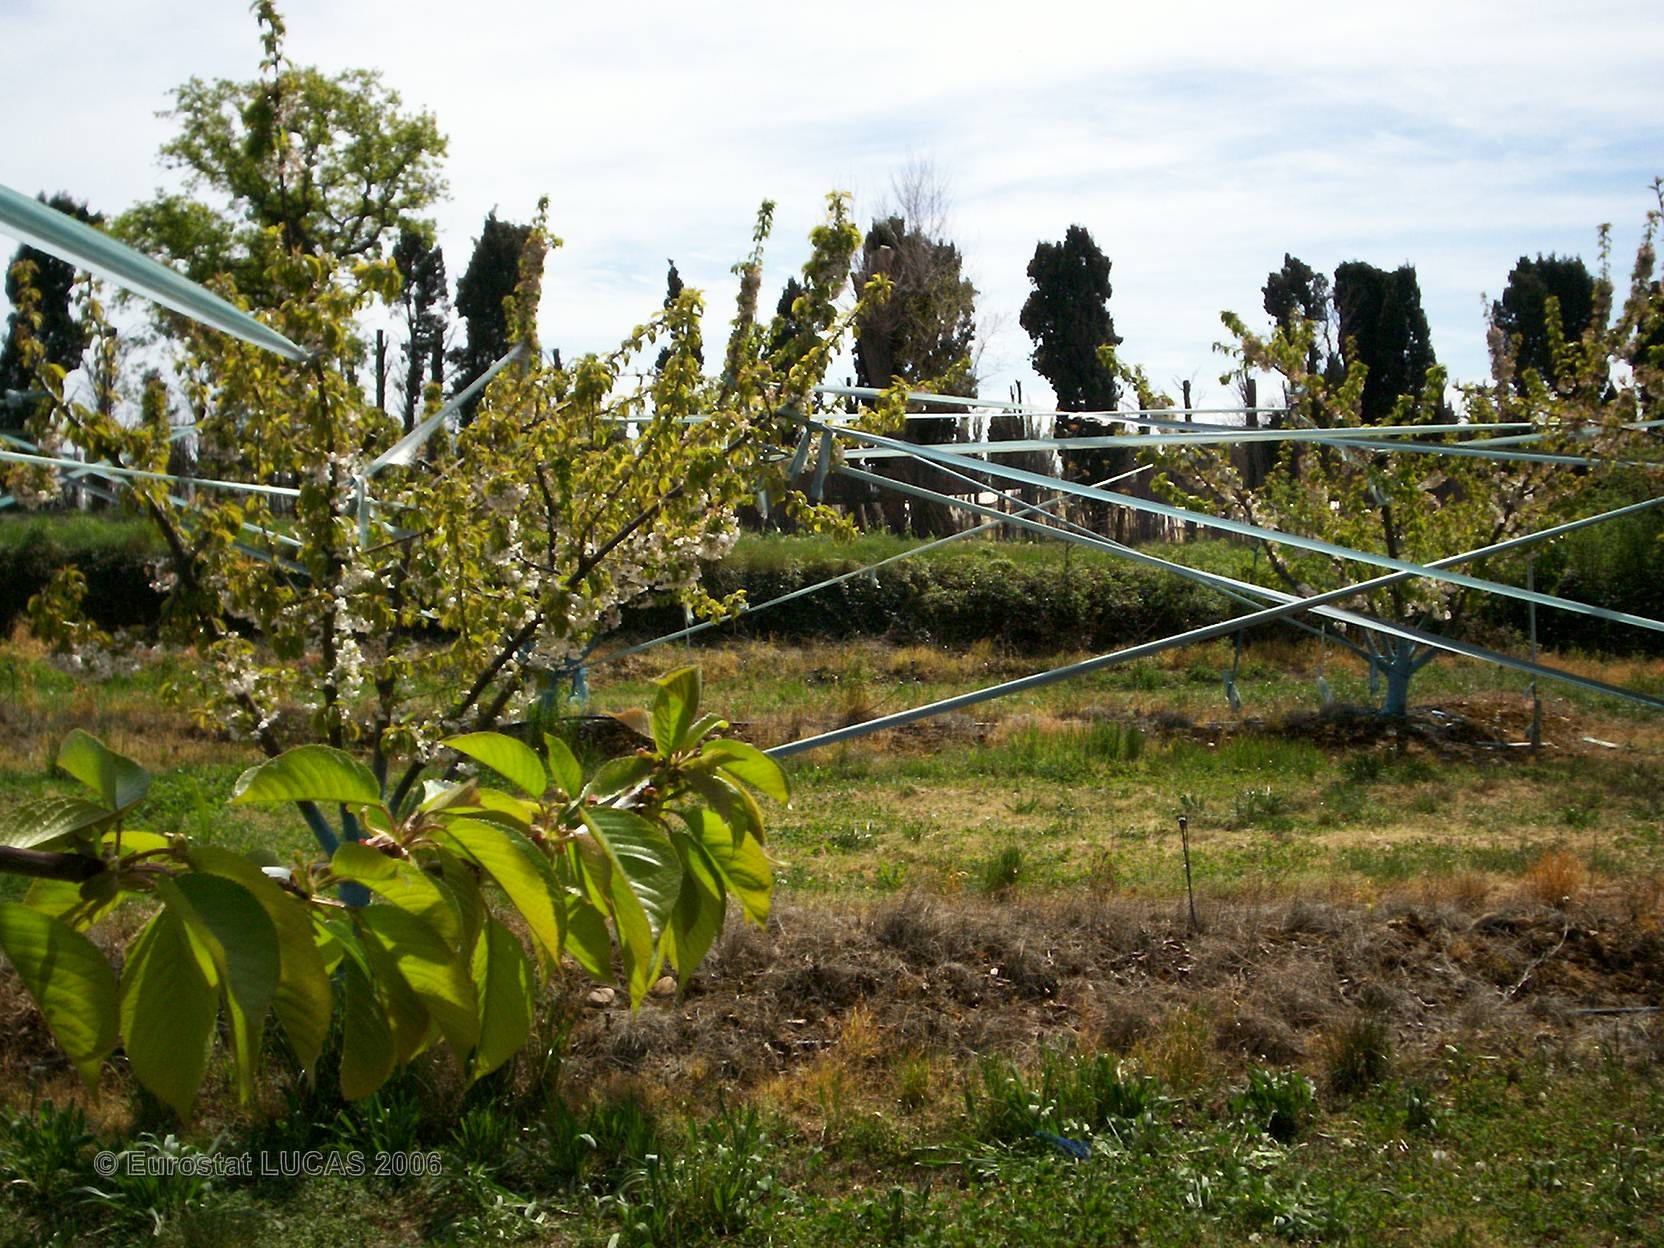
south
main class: Cropland
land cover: Cherry fruit
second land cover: Grassland with sparse tree/shrub cover
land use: Agriculture (excluding fallow land and kitchen gardens)
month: April
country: FR
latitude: 43.6872
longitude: 4.9850
